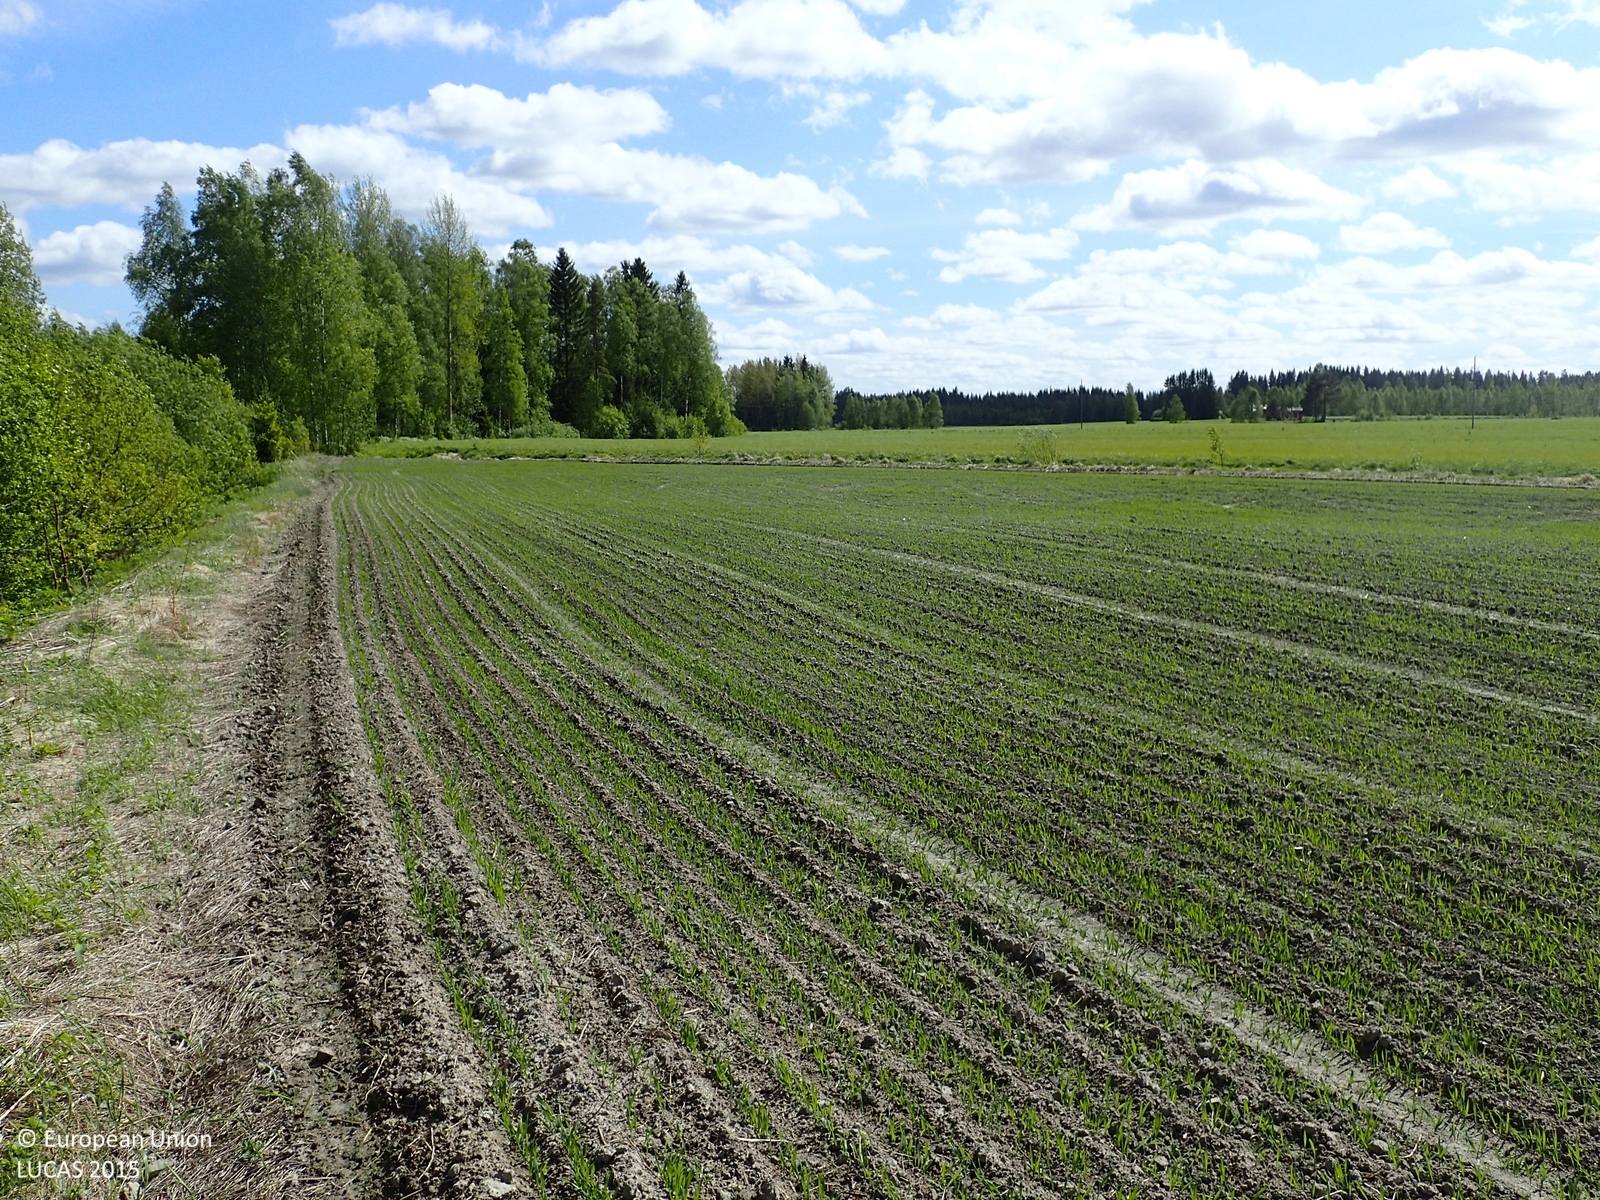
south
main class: Cropland
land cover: Oats
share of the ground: 25 - 50 %
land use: Agriculture (excluding fallow land and kitchen gardens)
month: June
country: FI
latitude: 62.1926
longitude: 22.9973
